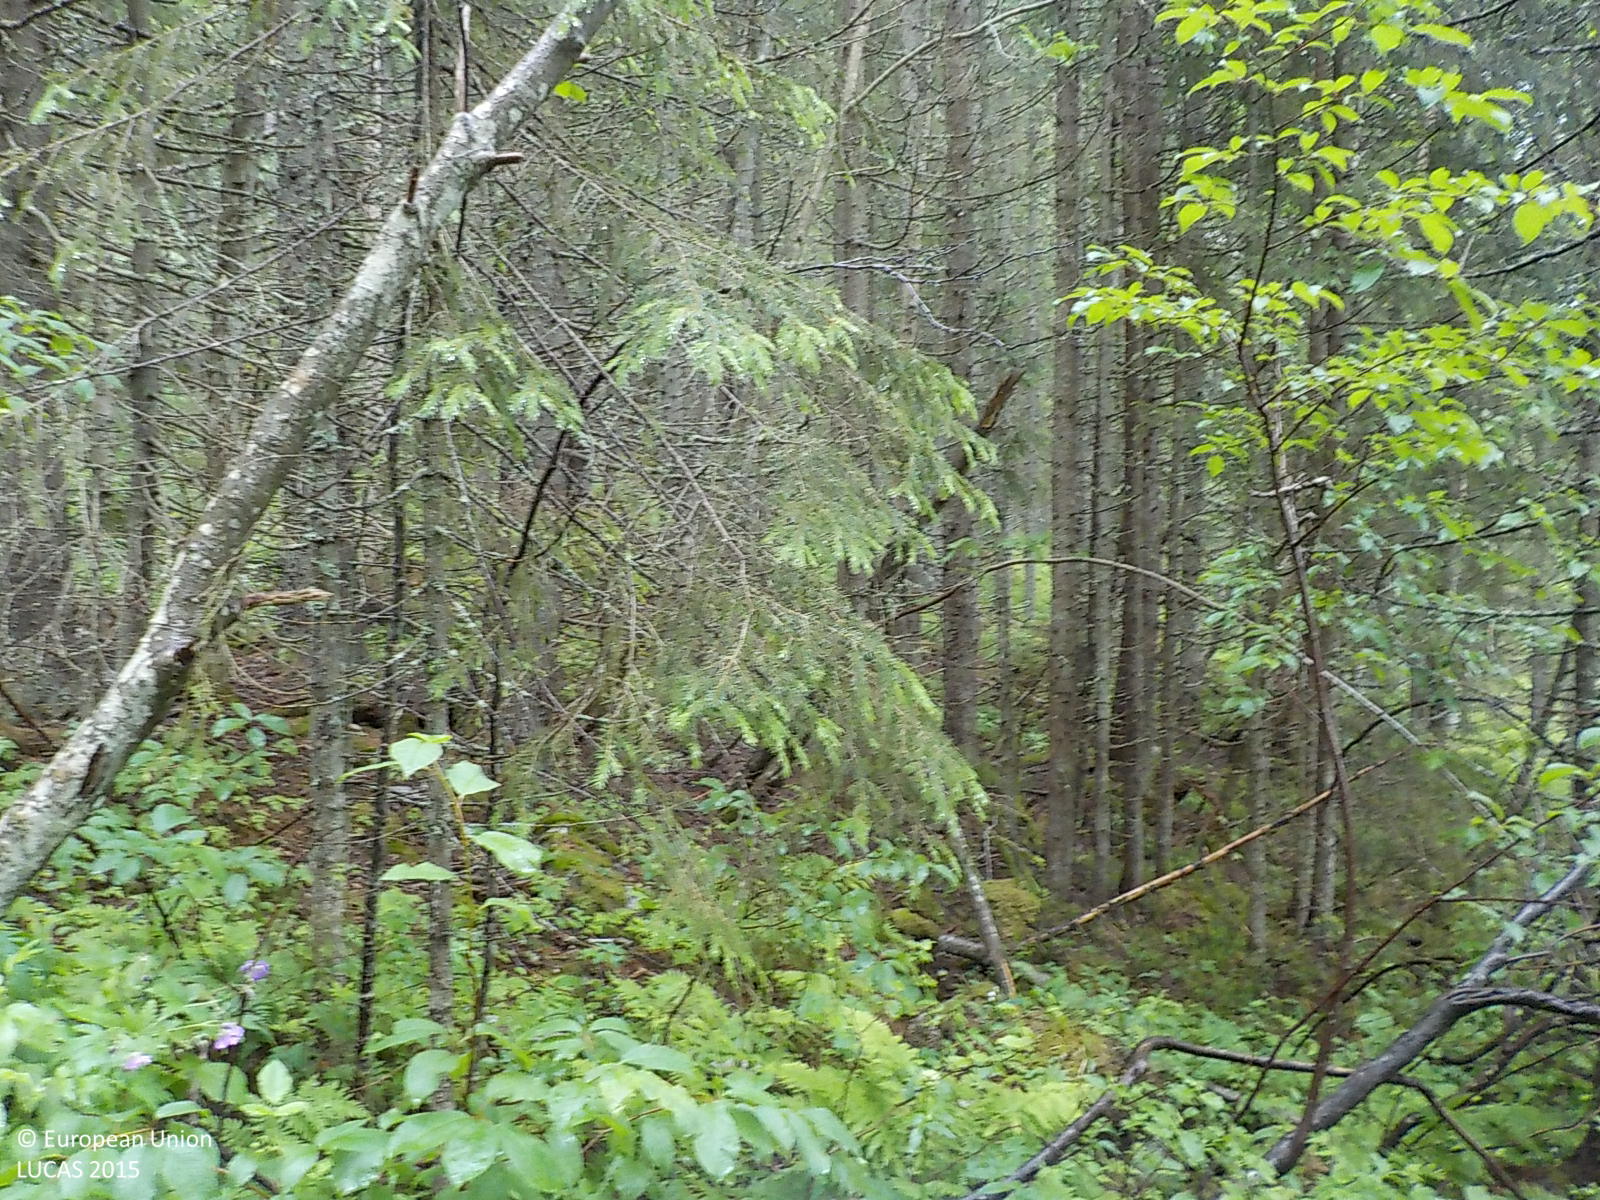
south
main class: Woodland
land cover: Spruce dominated mixed woodland
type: boreal forest
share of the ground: > 75 %
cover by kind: coniferous forest trees 60 %, broadleaved forest trees 20 %, herbaceous plants 20 %
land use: Forestry
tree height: > 5 m
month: July
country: SE
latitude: 63.0889
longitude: 17.9981
